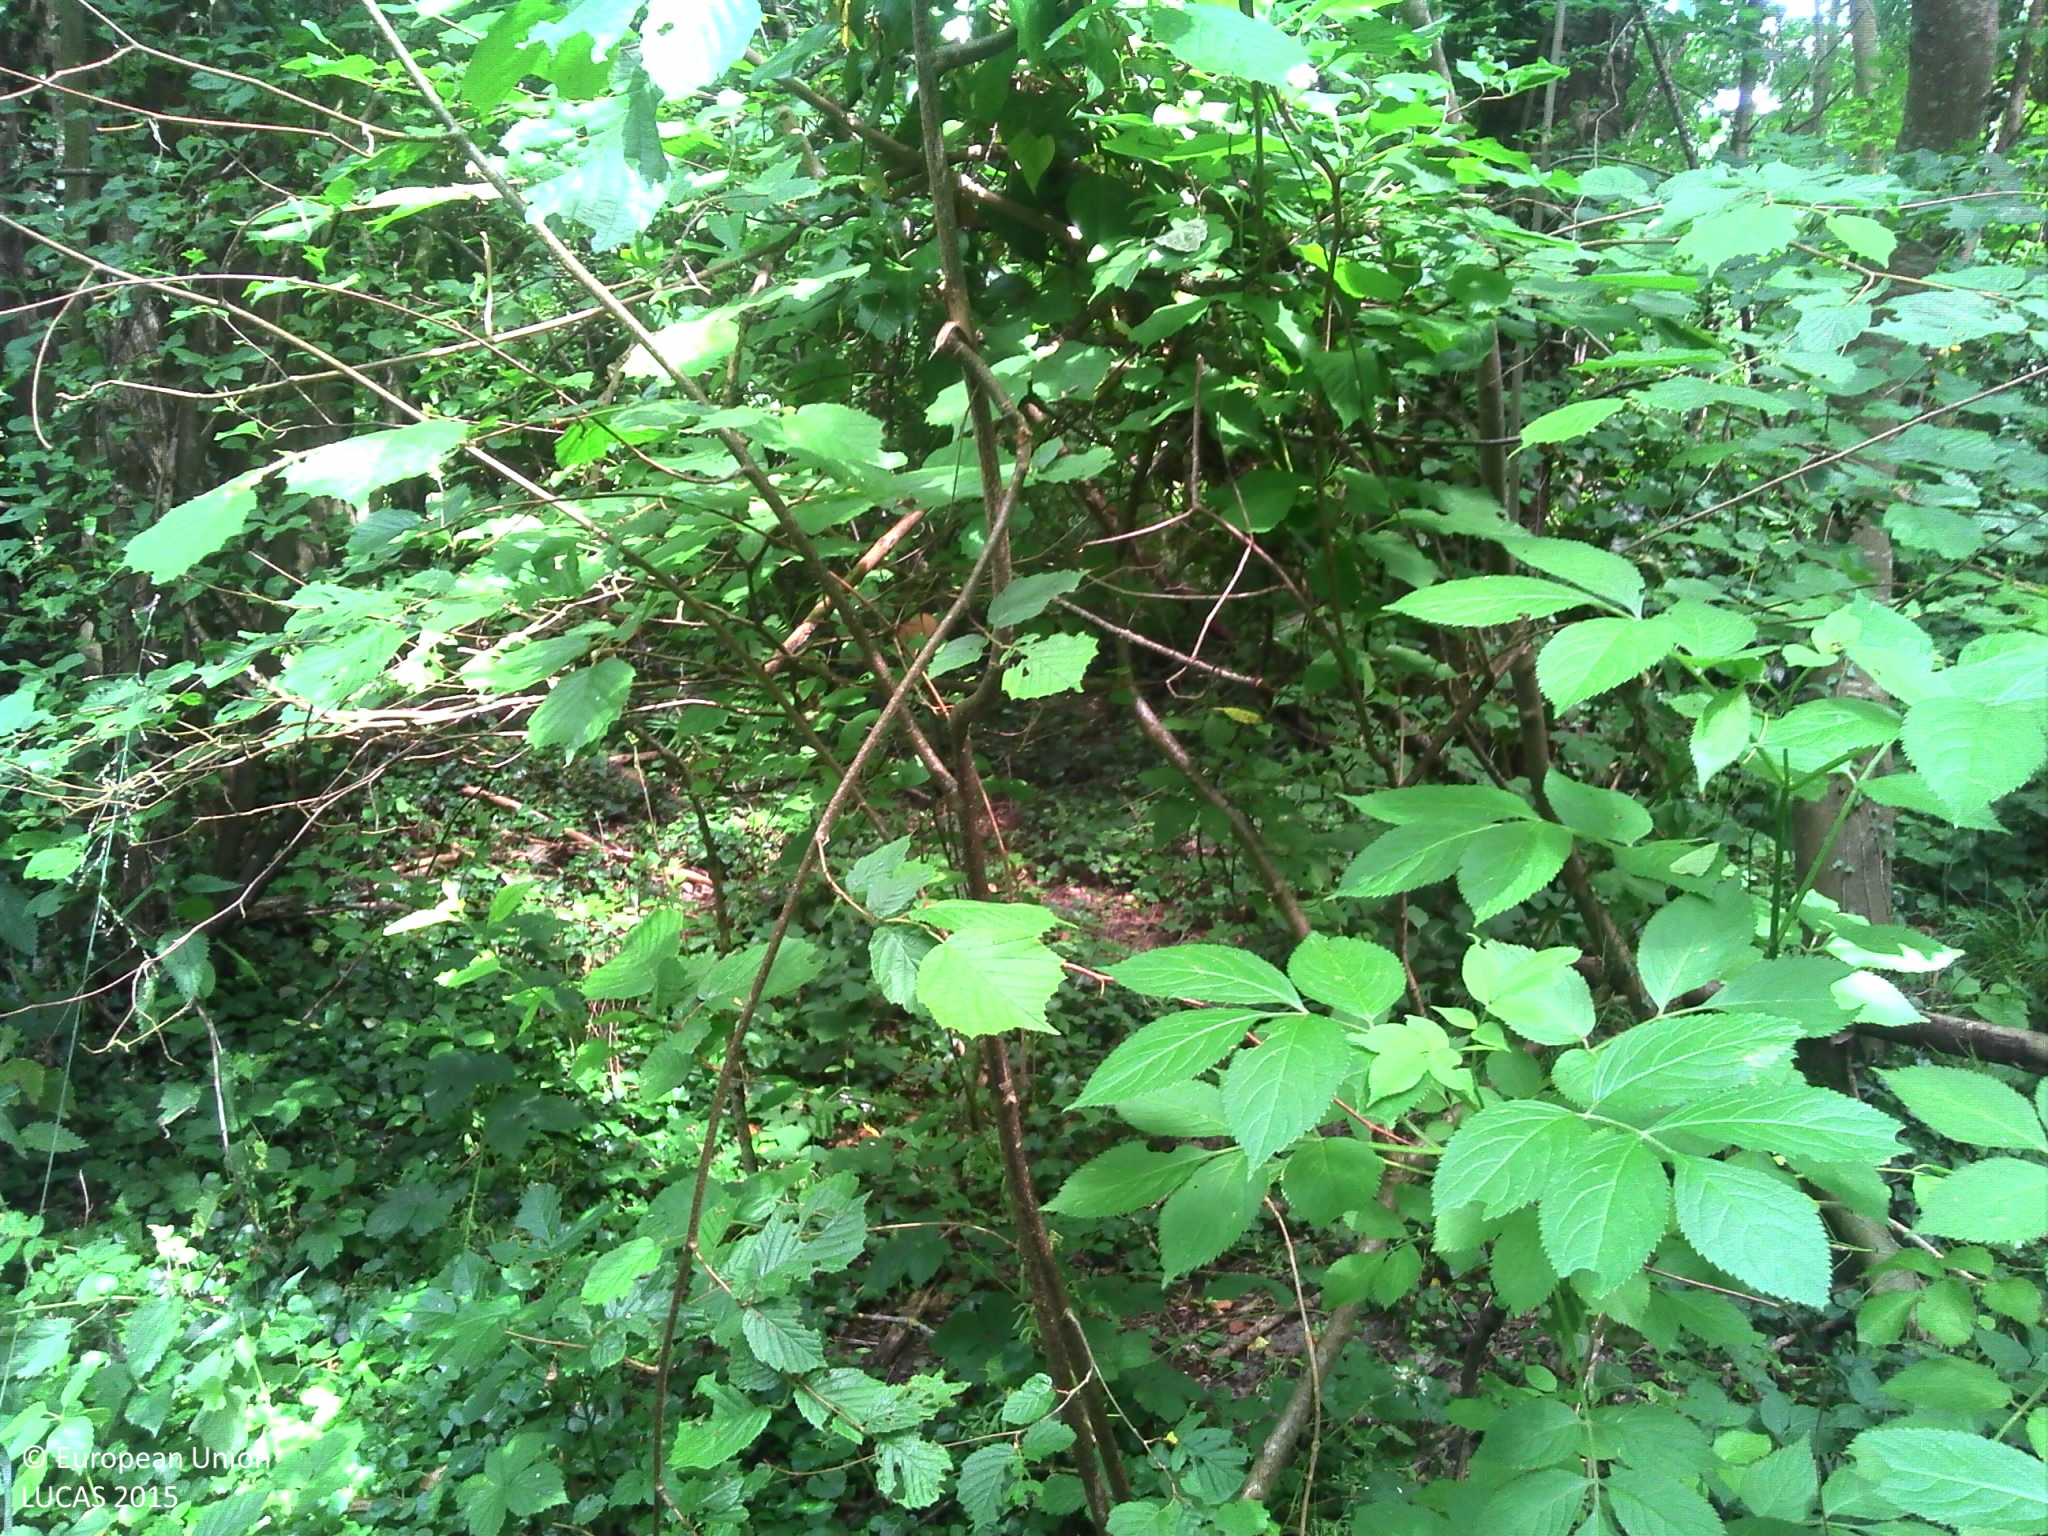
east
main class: Woodland
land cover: Broadleaved woodland
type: acidophilous oak and oak-birch forest
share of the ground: > 75 %
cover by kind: broadleaved forest trees 85 %, shrubs 10 %, herbaceous plants 5 %
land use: Forestry
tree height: > 5 m
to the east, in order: Broadleaved woodland; Maize; Electric lines; Maize; Broadleaved woodland; Shruby margins
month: June
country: FR
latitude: 49.3755
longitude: 3.6442
